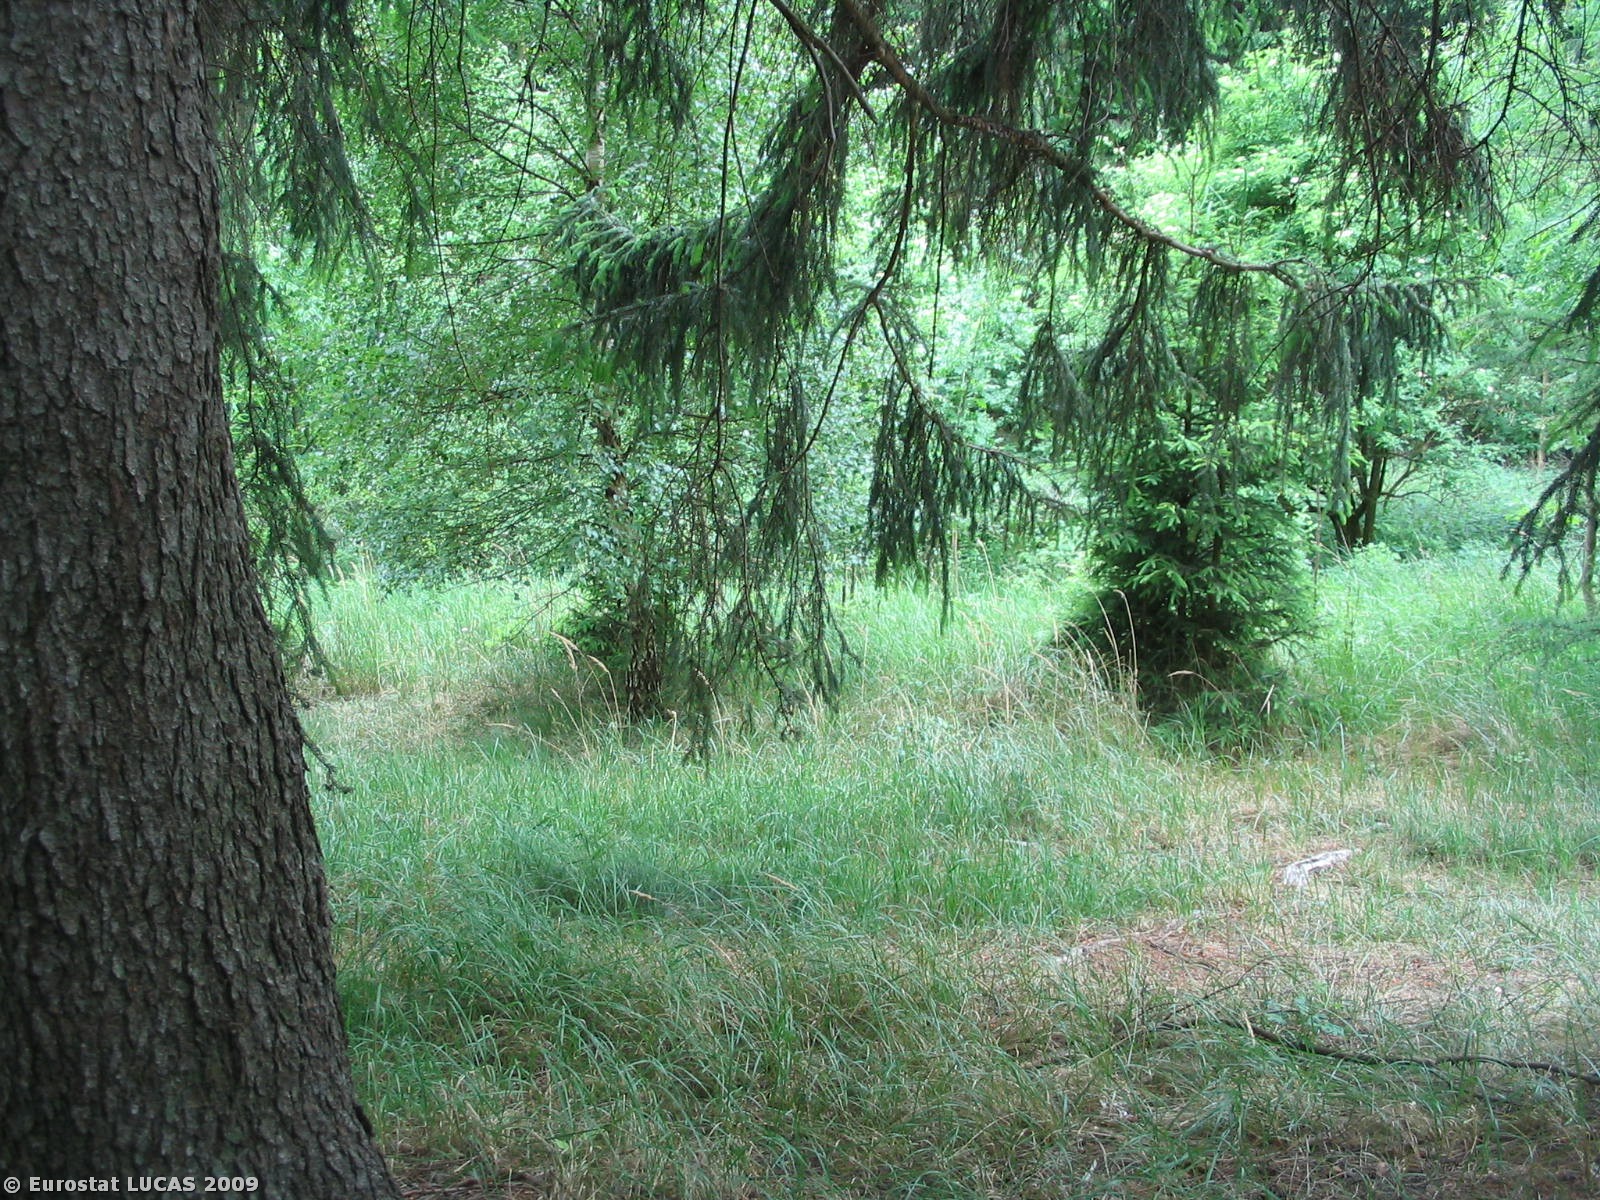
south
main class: Woodland
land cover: Coniferous woodland
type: hemiboreal forest and nemoral coniferous forest and mixed broadleaved-coniferous forest
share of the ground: > 75 %
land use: Forestry
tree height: > 5 m
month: May
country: CZ
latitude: 49.4409
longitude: 16.4752
